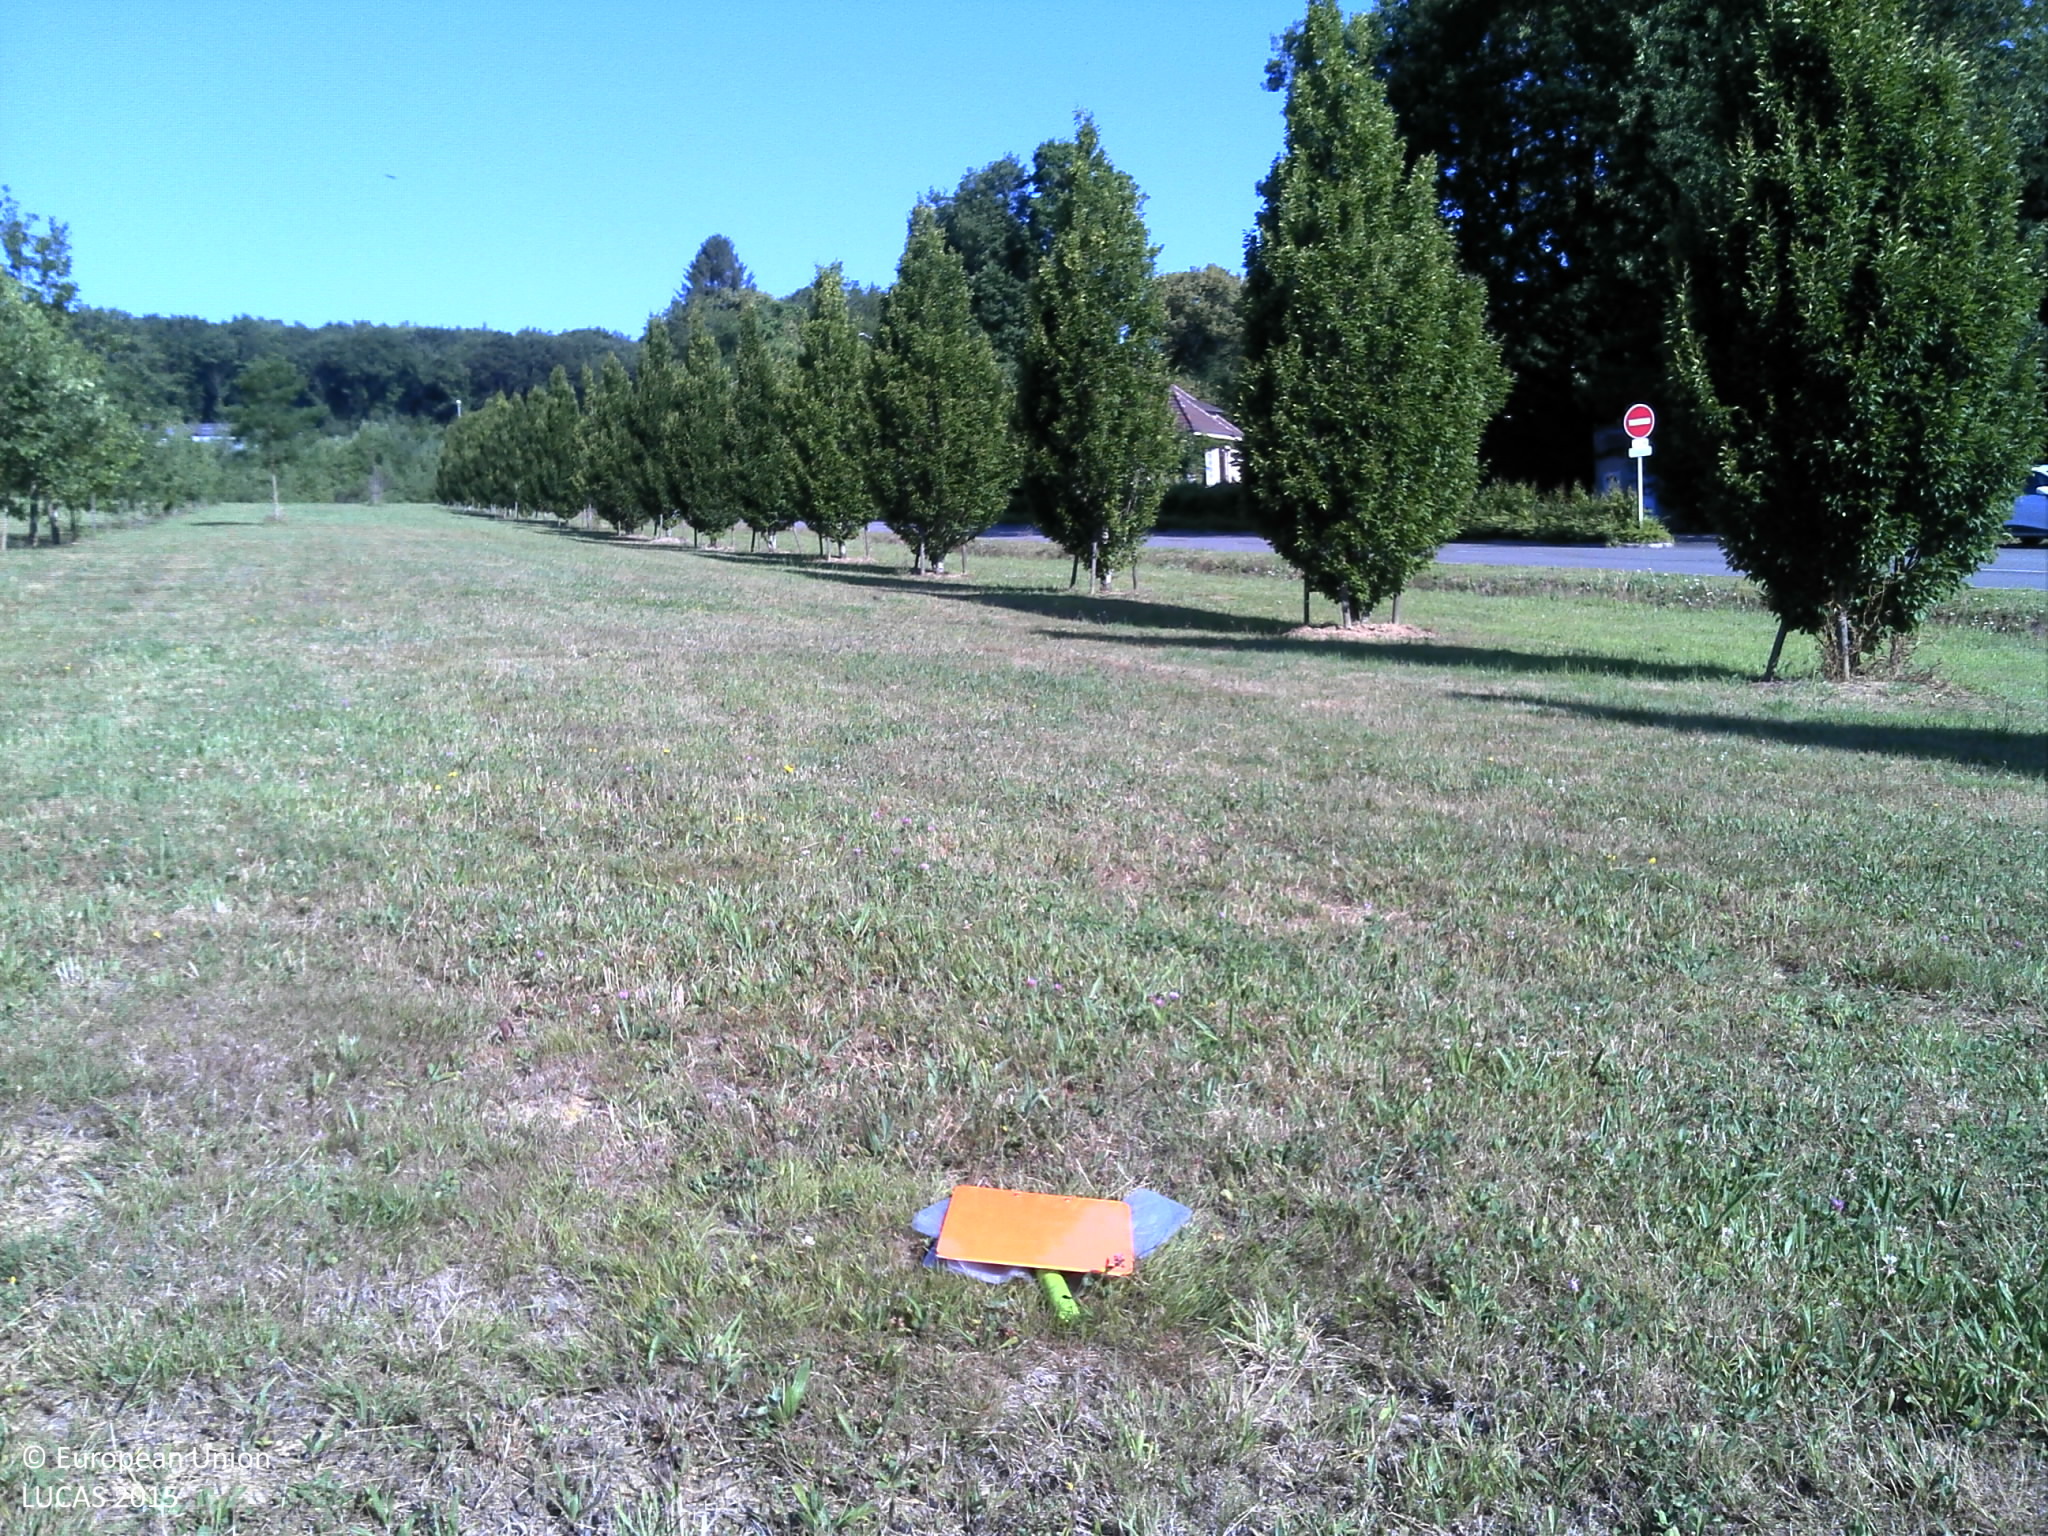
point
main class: Grassland
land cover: Grassland with sparse tree/shrub cover
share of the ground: > 75 %
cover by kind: herbaceous plants 95 %, broadleaved forest trees 5 %
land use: Semi-natural and natural areas not in use
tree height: < 5 m
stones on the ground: > 50 %
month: June
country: FR
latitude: 49.9881
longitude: 4.6824
